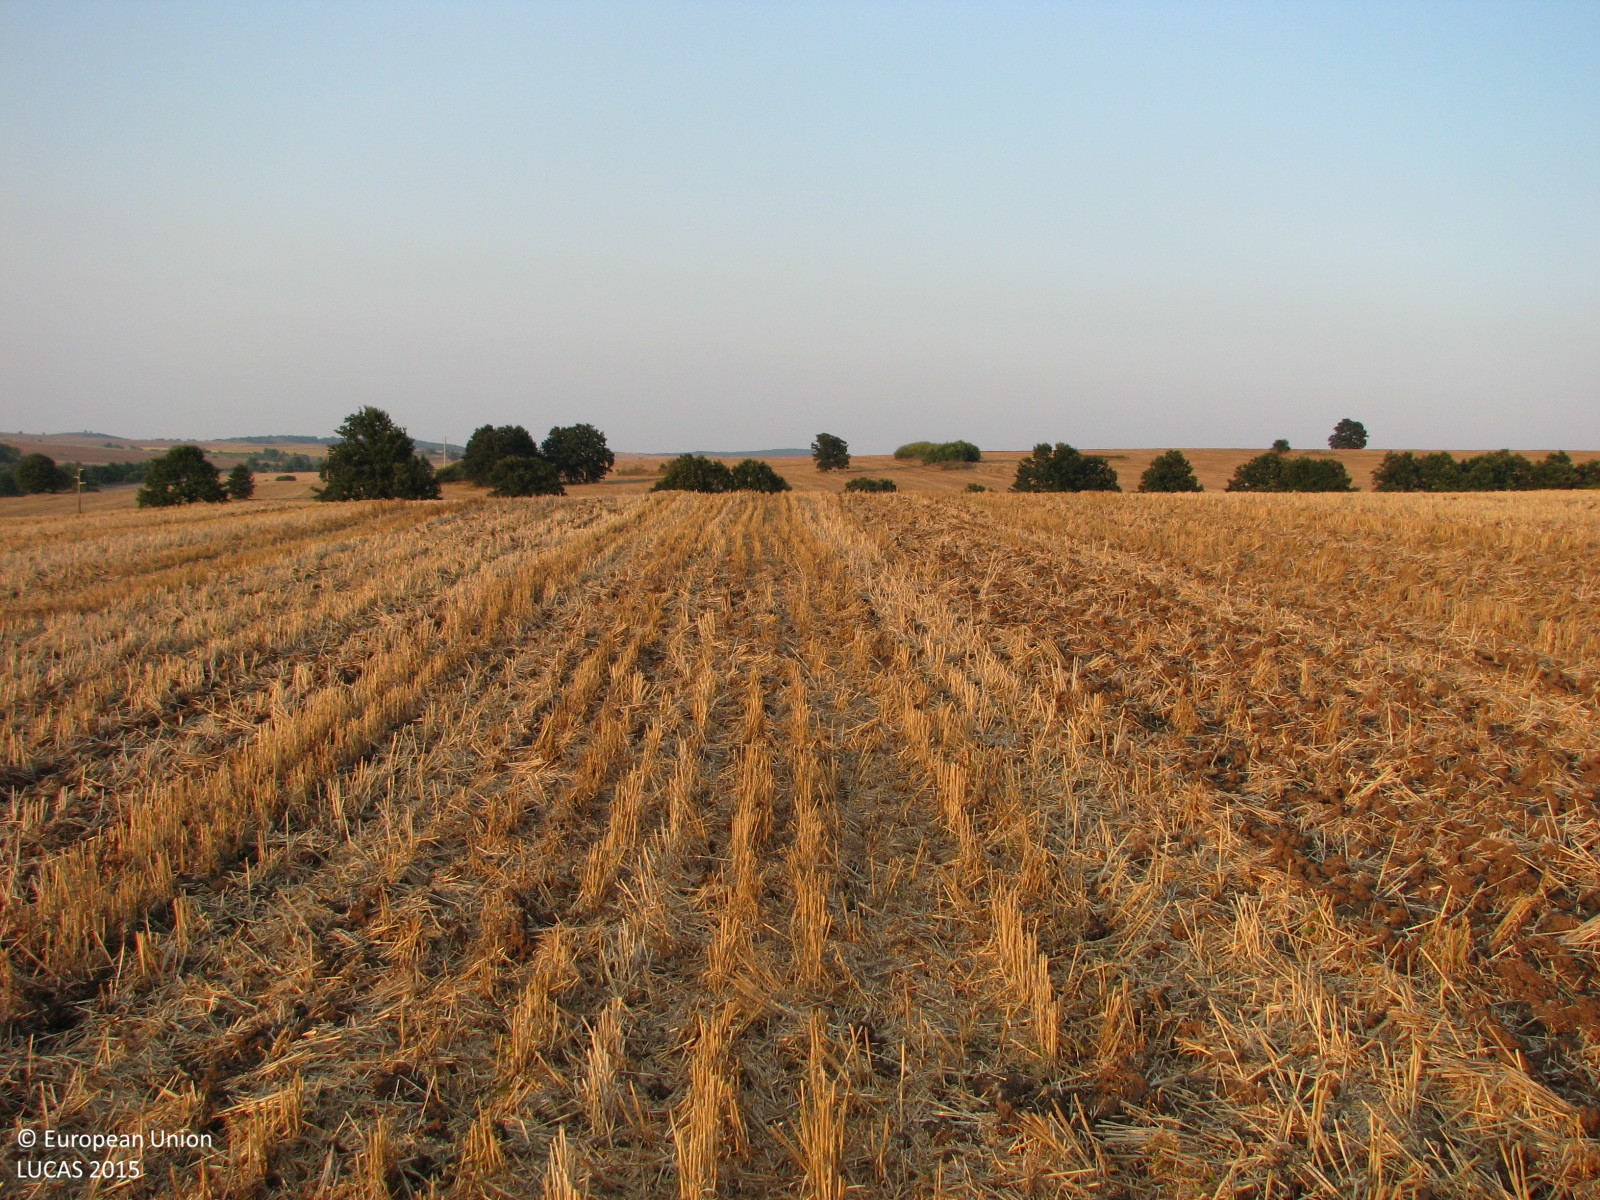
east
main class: Cropland
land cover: Common wheat
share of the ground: 25 - 50 %
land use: Agriculture (excluding fallow land and kitchen gardens)
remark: Harvested field
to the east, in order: Common wheat
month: August
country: BG
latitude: 42.1808
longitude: 26.8901
